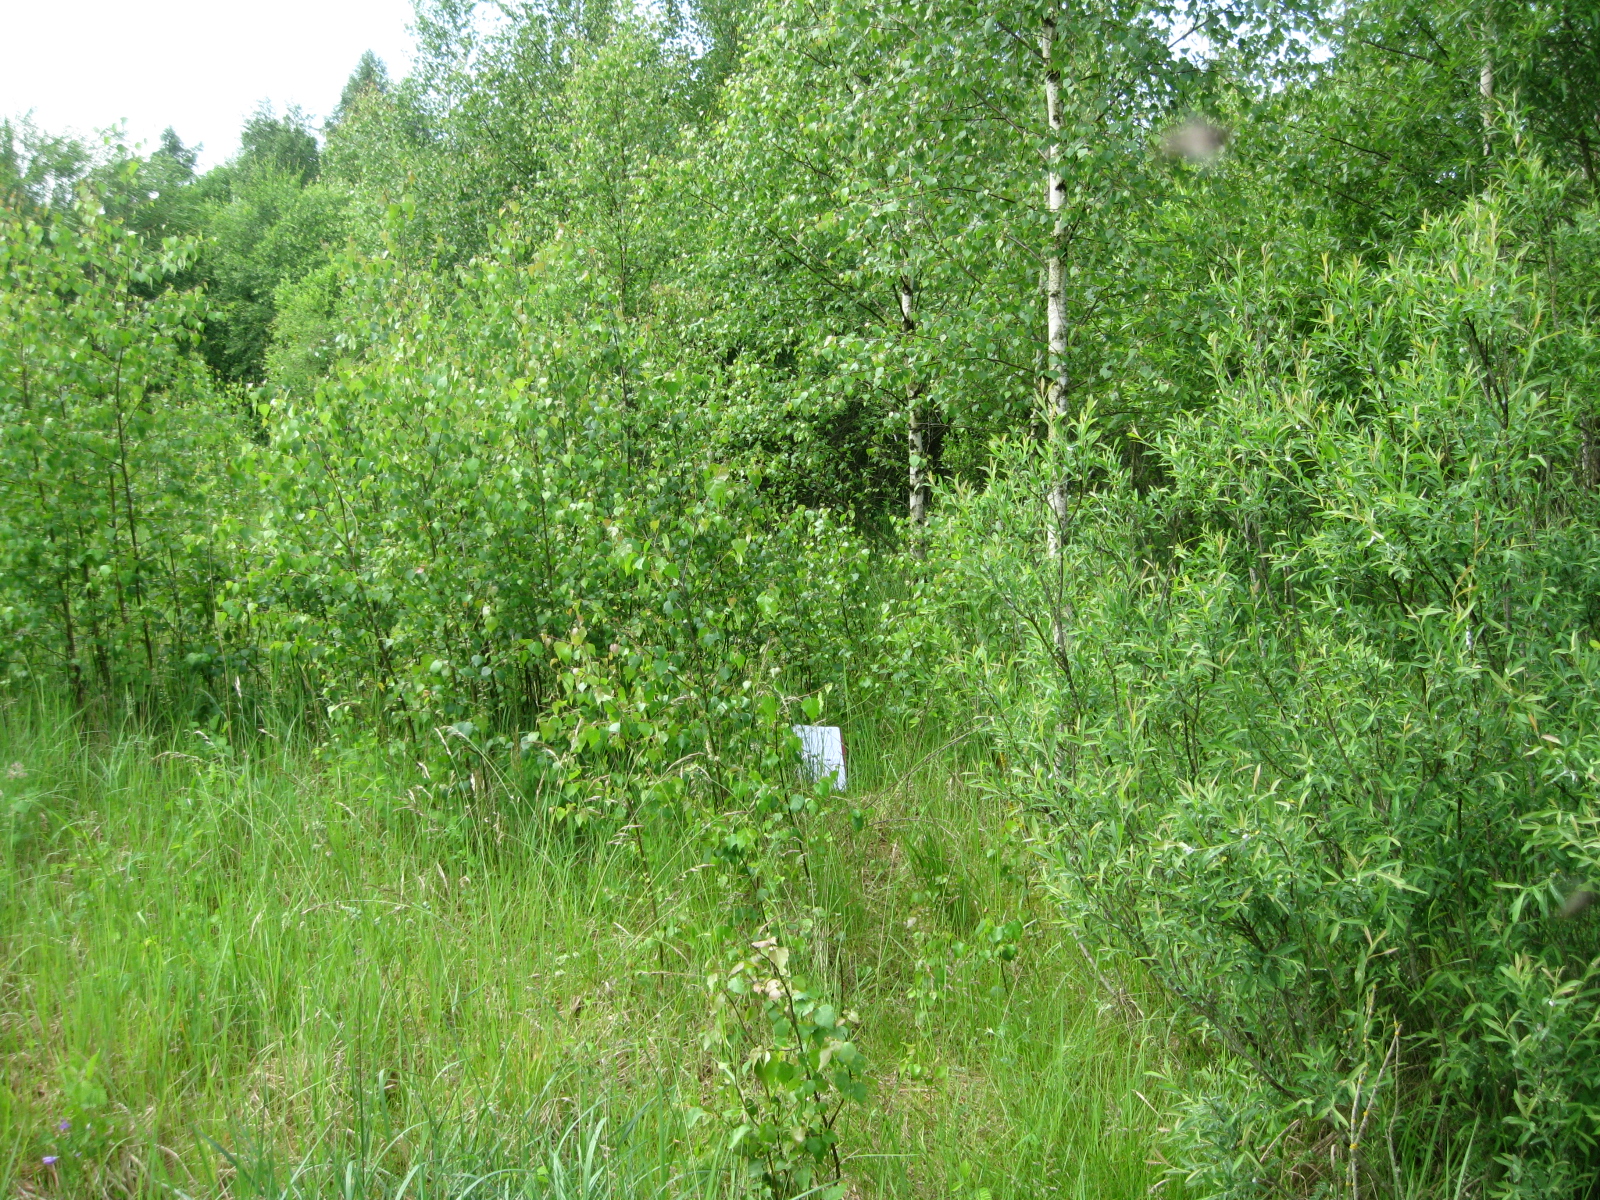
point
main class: Woodland
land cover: Broadleaved woodland
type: non-riverine alder, birch or aspen forest
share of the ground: 50 - 75 %
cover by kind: broadleaved forest trees 60 %, herbaceous plants 30 %, shrubs 10 %
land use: Semi-natural and natural areas not in use
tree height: < 5 m
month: June
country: LT
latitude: 55.5936
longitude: 24.0379
